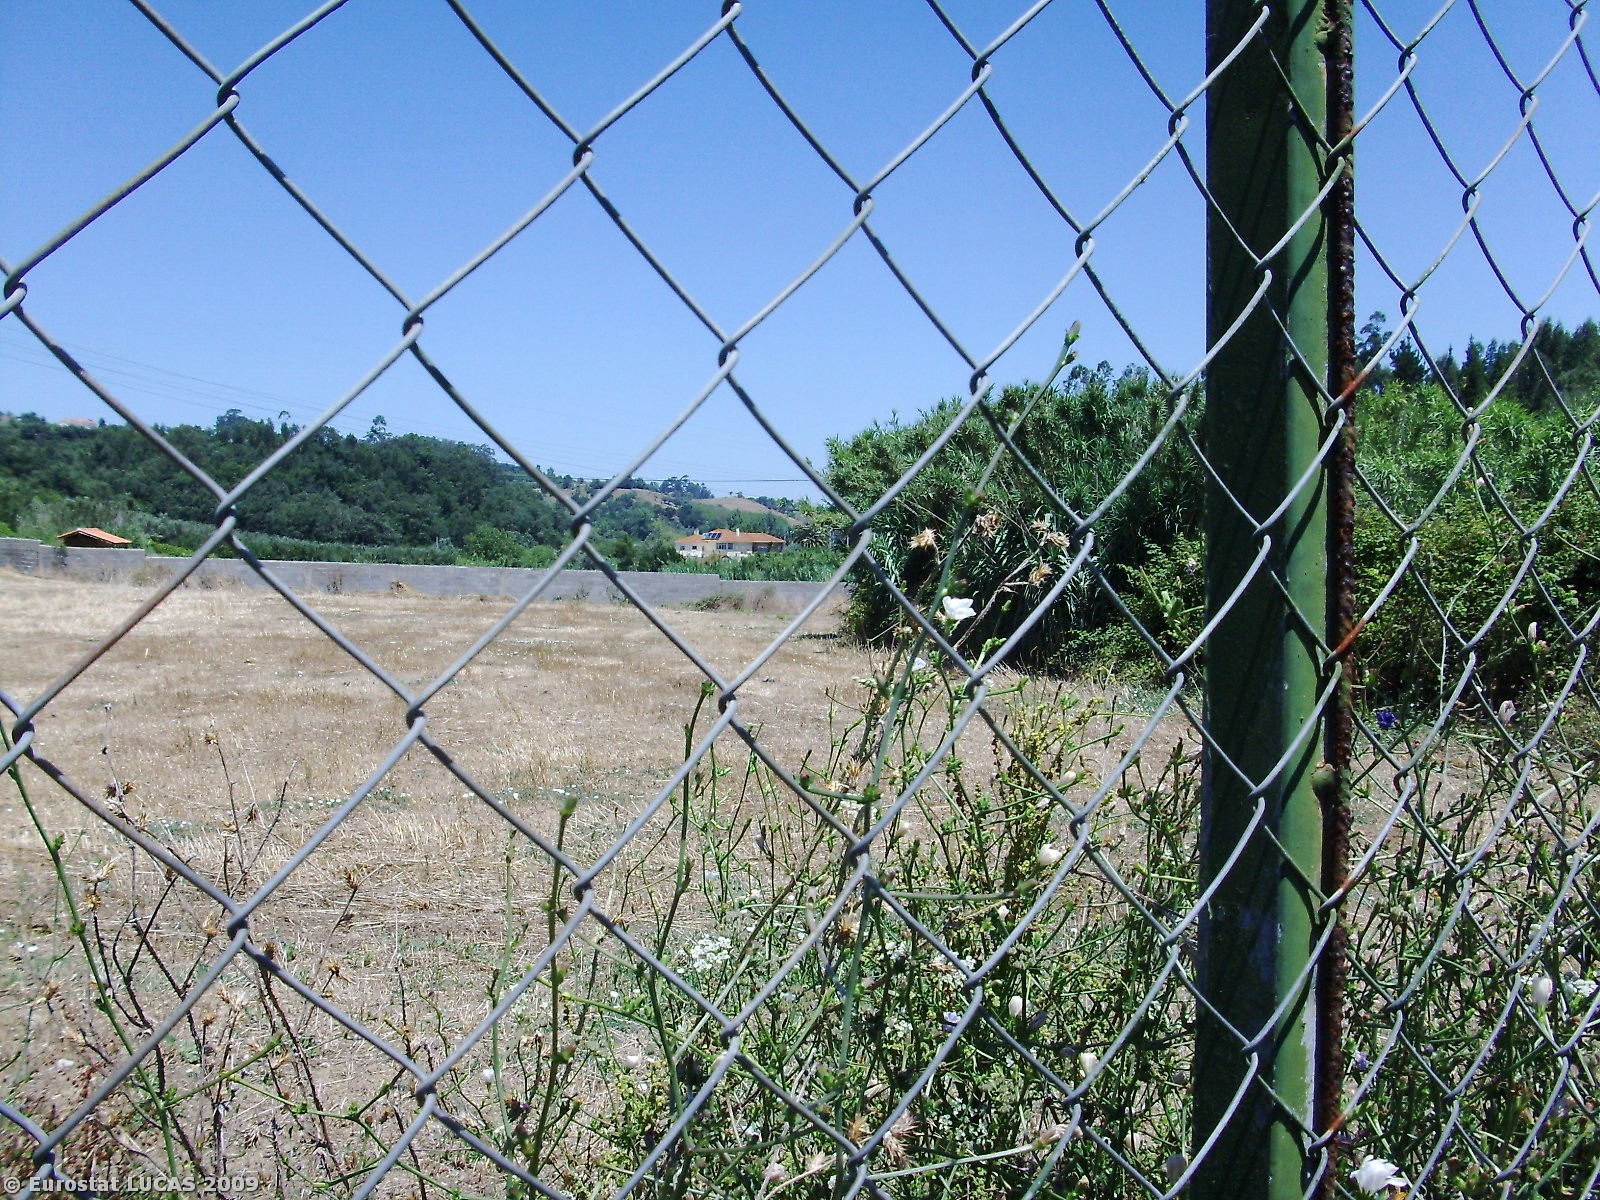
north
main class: Grassland
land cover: Grassland without tree/shrub cover
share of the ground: > 75 %
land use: Agriculture (excluding fallow land and kitchen gardens)
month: July
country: PT
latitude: 39.6114
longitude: -8.8247
